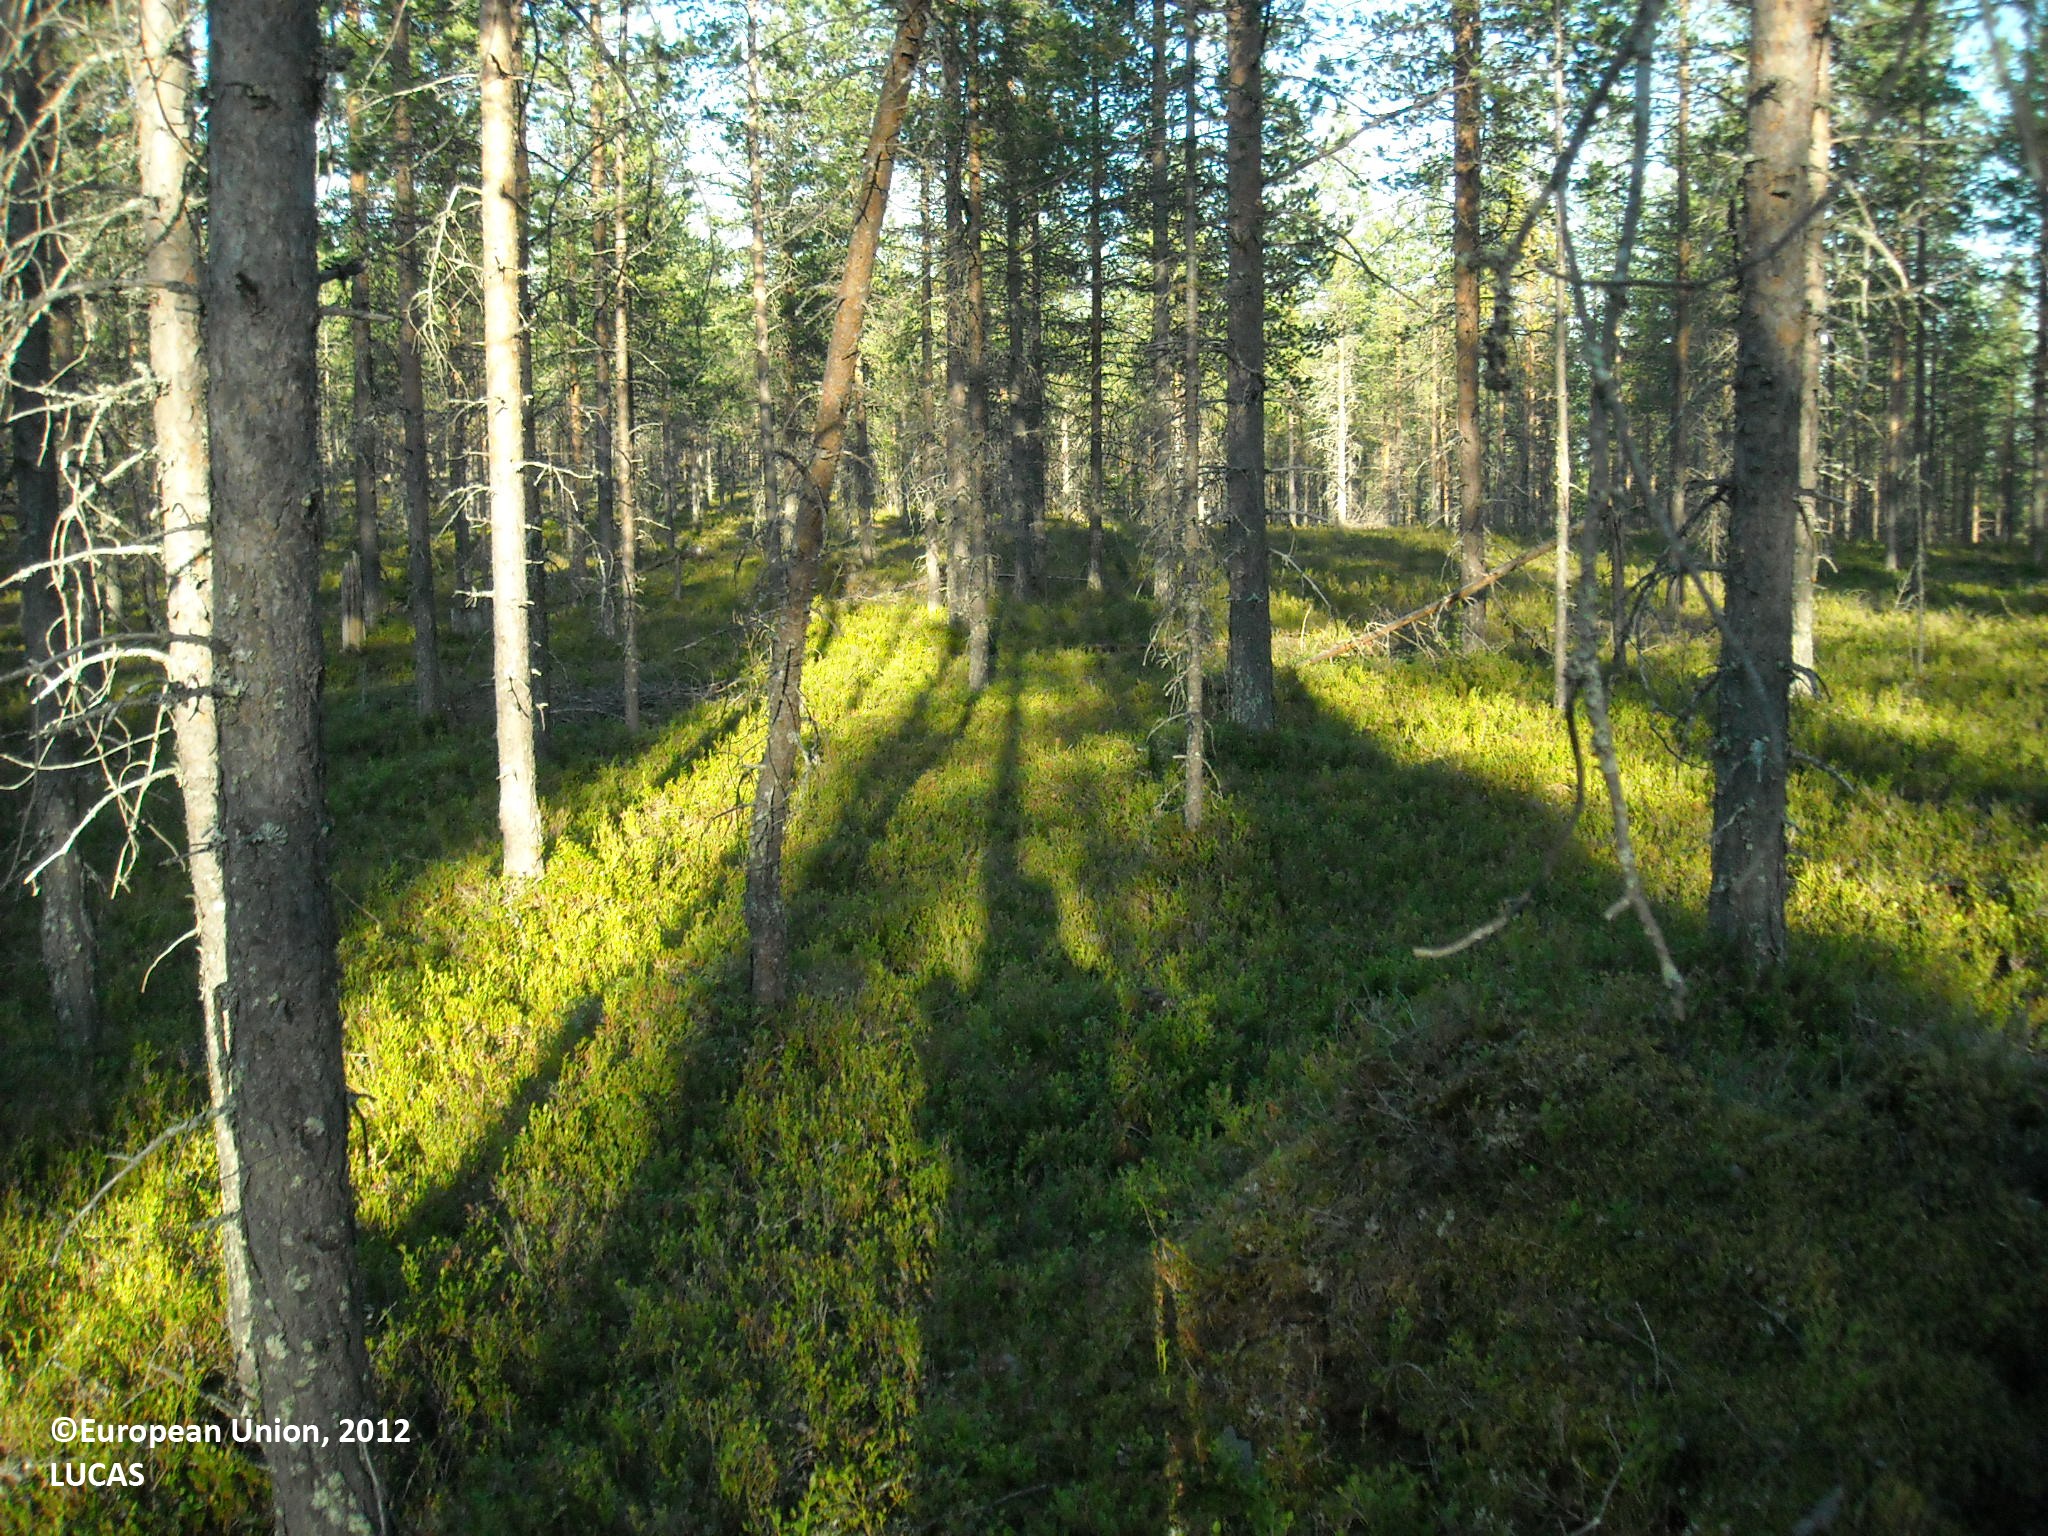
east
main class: Woodland
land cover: Pine dominated coniferous woodland
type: boreal forest
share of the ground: 25 - 50 %
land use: Forestry
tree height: > 5 m
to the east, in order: Pine dominated coniferous woodland; Tracks; Pine dominated coniferous woodland
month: August
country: FI
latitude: 65.4692
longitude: 27.7738
